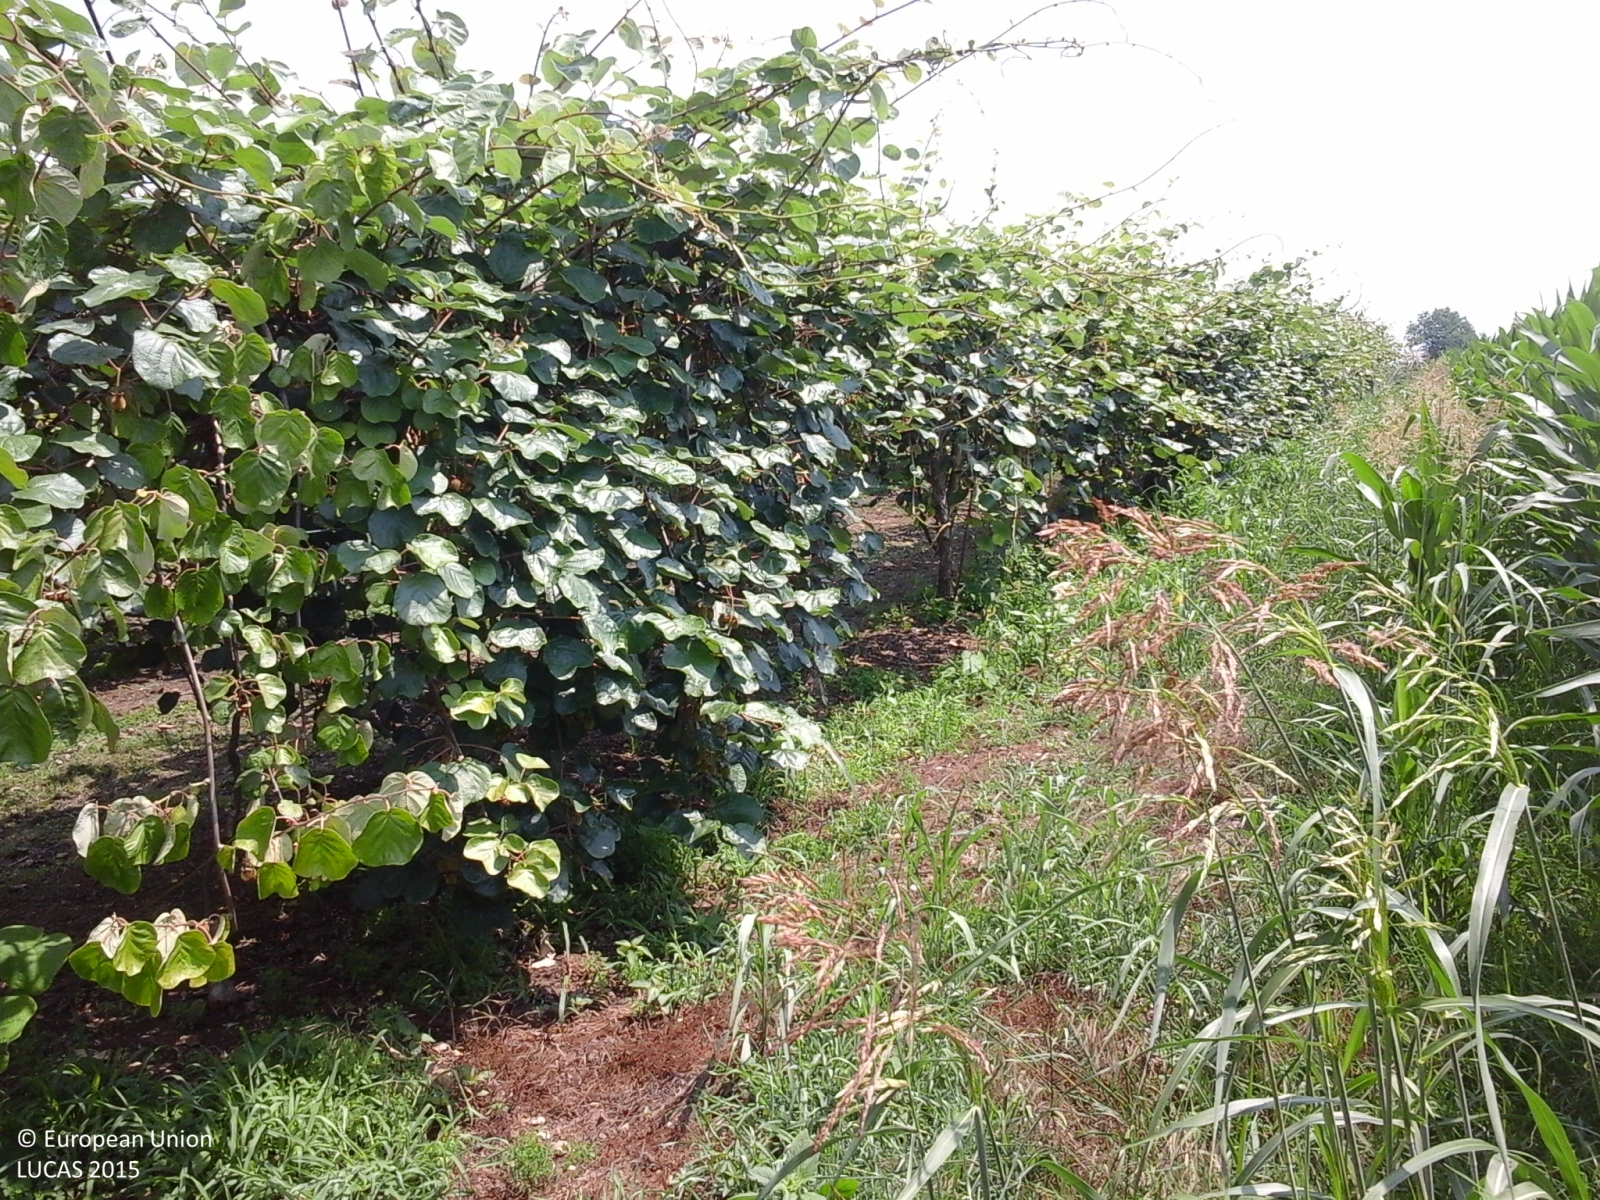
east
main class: Cropland
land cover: Maize
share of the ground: > 75 %
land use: Agriculture (excluding fallow land and kitchen gardens)
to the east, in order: Maize; Grass margins; Other fruit trees and berries; Grassland without tree/shrub cover; Tracks; Electric lines; Fences; Lucerne; Fences; Tracks; Grass margins; Abandoned hedges; Inland fresh running water; Abandoned hedges; Grass margins; Paved roads, cycling and walking lanes
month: June
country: IT
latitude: 45.3572
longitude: 10.8028
